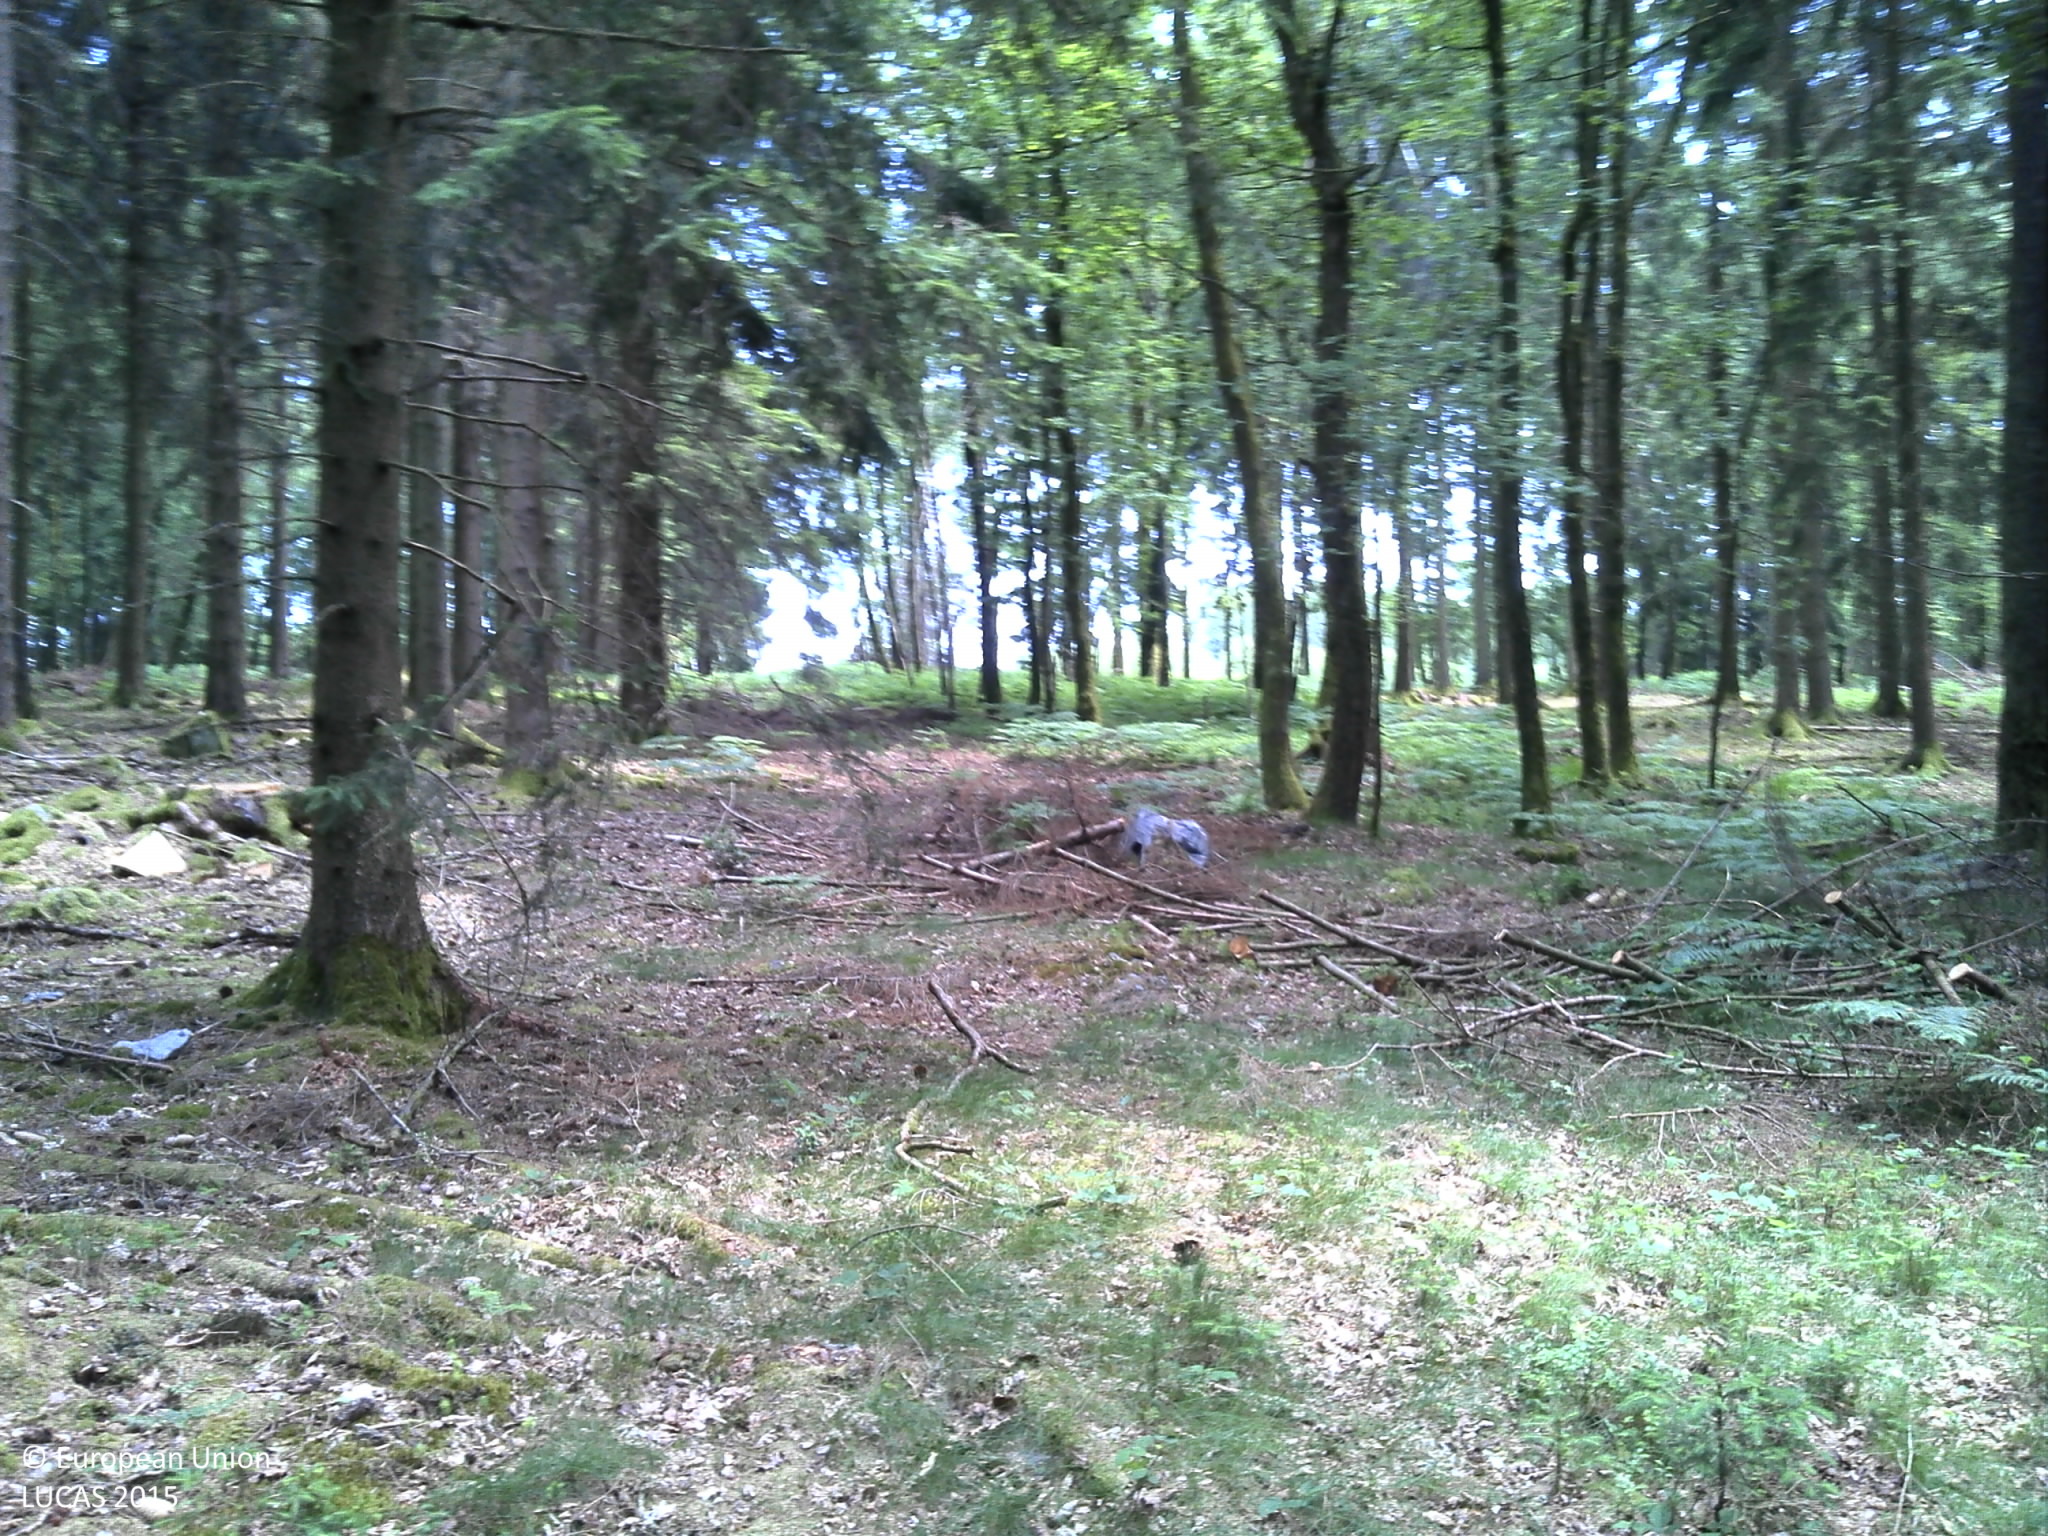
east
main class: Woodland
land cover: Spruce dominated mixed woodland
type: mountainous beech forest
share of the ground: 50 - 75 %
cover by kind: coniferous forest trees 50 %, broadleaved forest trees 25 %, herbaceous plants 10 %, lichens and mosses 10 %, consolidated bare surface 5 %
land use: Forestry
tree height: > 5 m
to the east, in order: Spruce dominated mixed woodland; Tracks; Broadleaved woodland; Tracks; Ditches and canals; Broadleaved woodland; Grass margins; Tracks
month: July
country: FR
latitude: 49.9177
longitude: 4.7182
